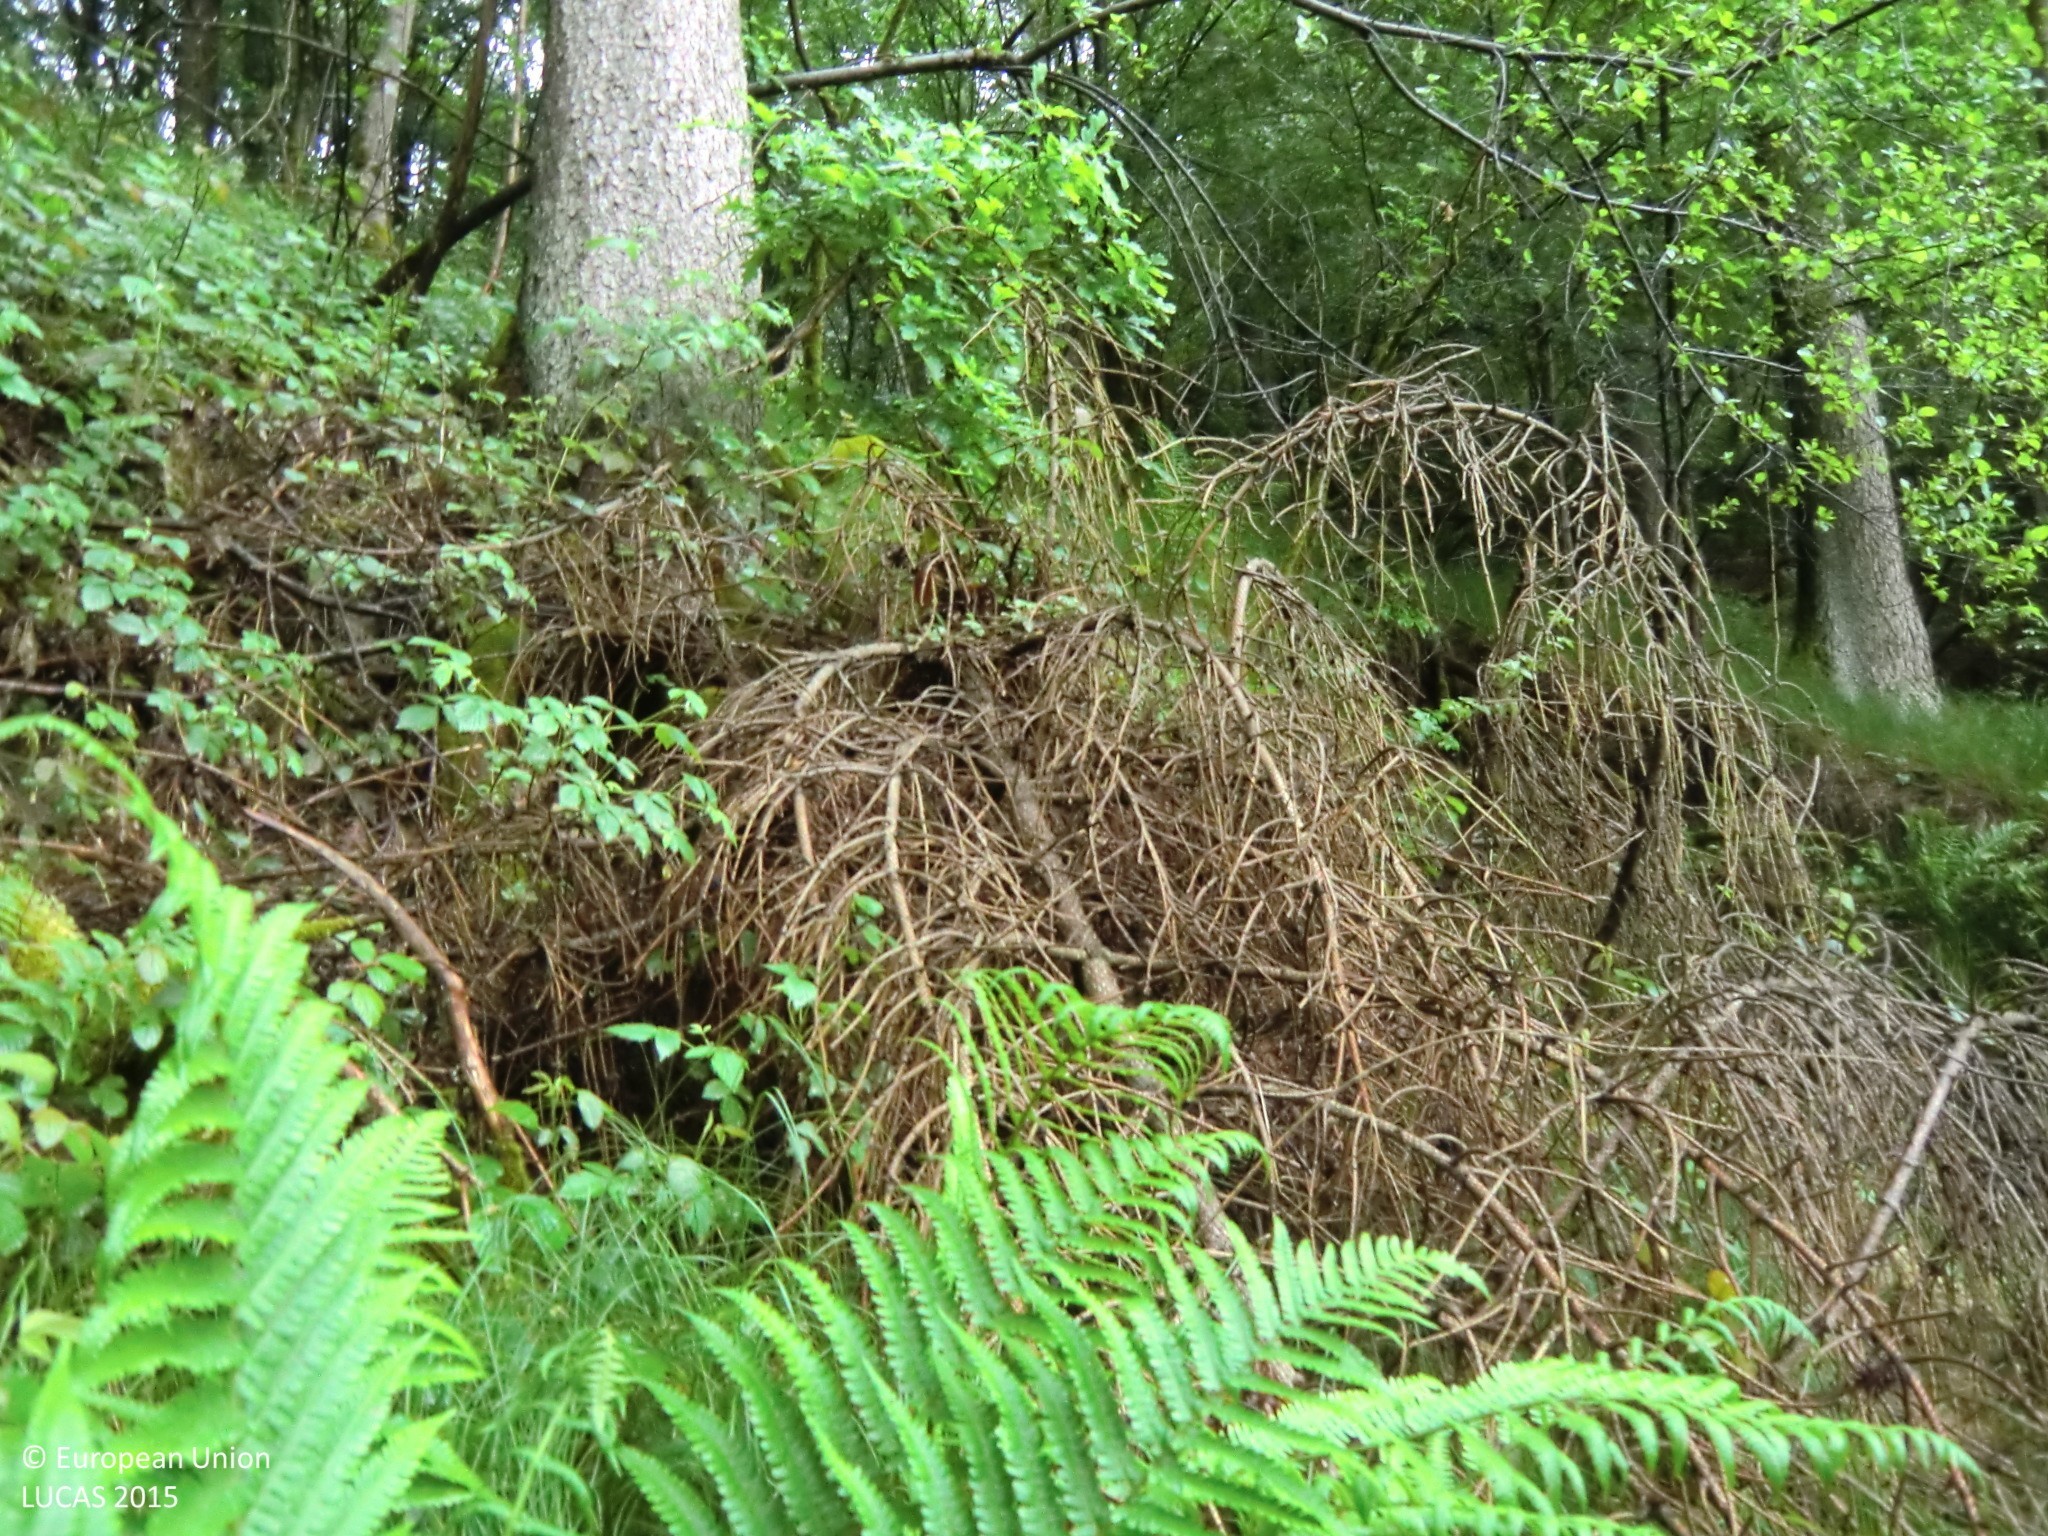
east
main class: Woodland
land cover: Spruce dominated mixed woodland
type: hemiboreal forest and nemoral coniferous forest and mixed broadleaved-coniferous forest
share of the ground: > 75 %
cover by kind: coniferous forest trees 40 %, broadleaved forest trees 40 %, herbaceous plants 20 %
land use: Forestry
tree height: > 5 m
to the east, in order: Spruce dominated mixed woodland; Artificial constructions in urban areas; Broadleaved woodland; Inland fresh running water; Electric lines; Shrubland without tree cover; Grassland without tree/shrub cover
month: May
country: AT
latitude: 48.3629
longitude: 14.5762
